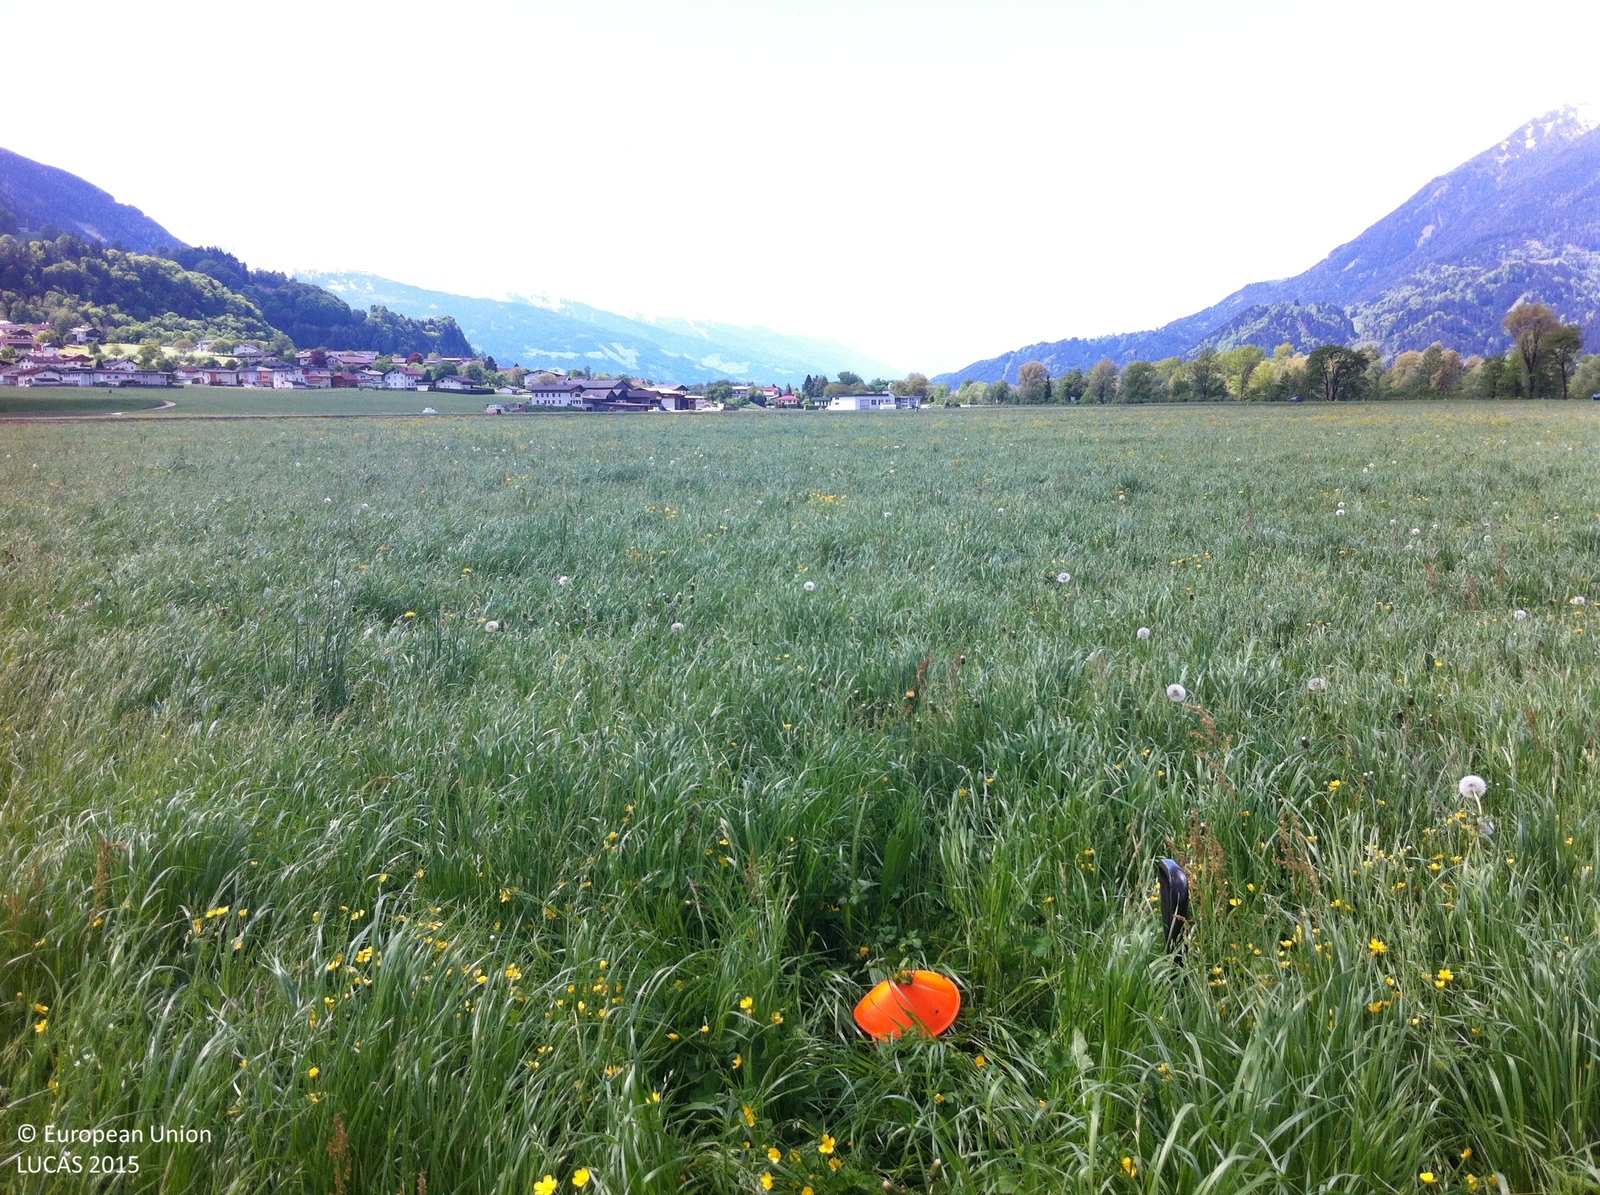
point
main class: Grassland
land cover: Grassland without tree/shrub cover
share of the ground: > 75 %
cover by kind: herbaceous plants 100 %
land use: Agriculture (excluding fallow land and kitchen gardens)
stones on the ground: < 10 %
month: May
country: AT
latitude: 47.3814
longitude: 11.7602
